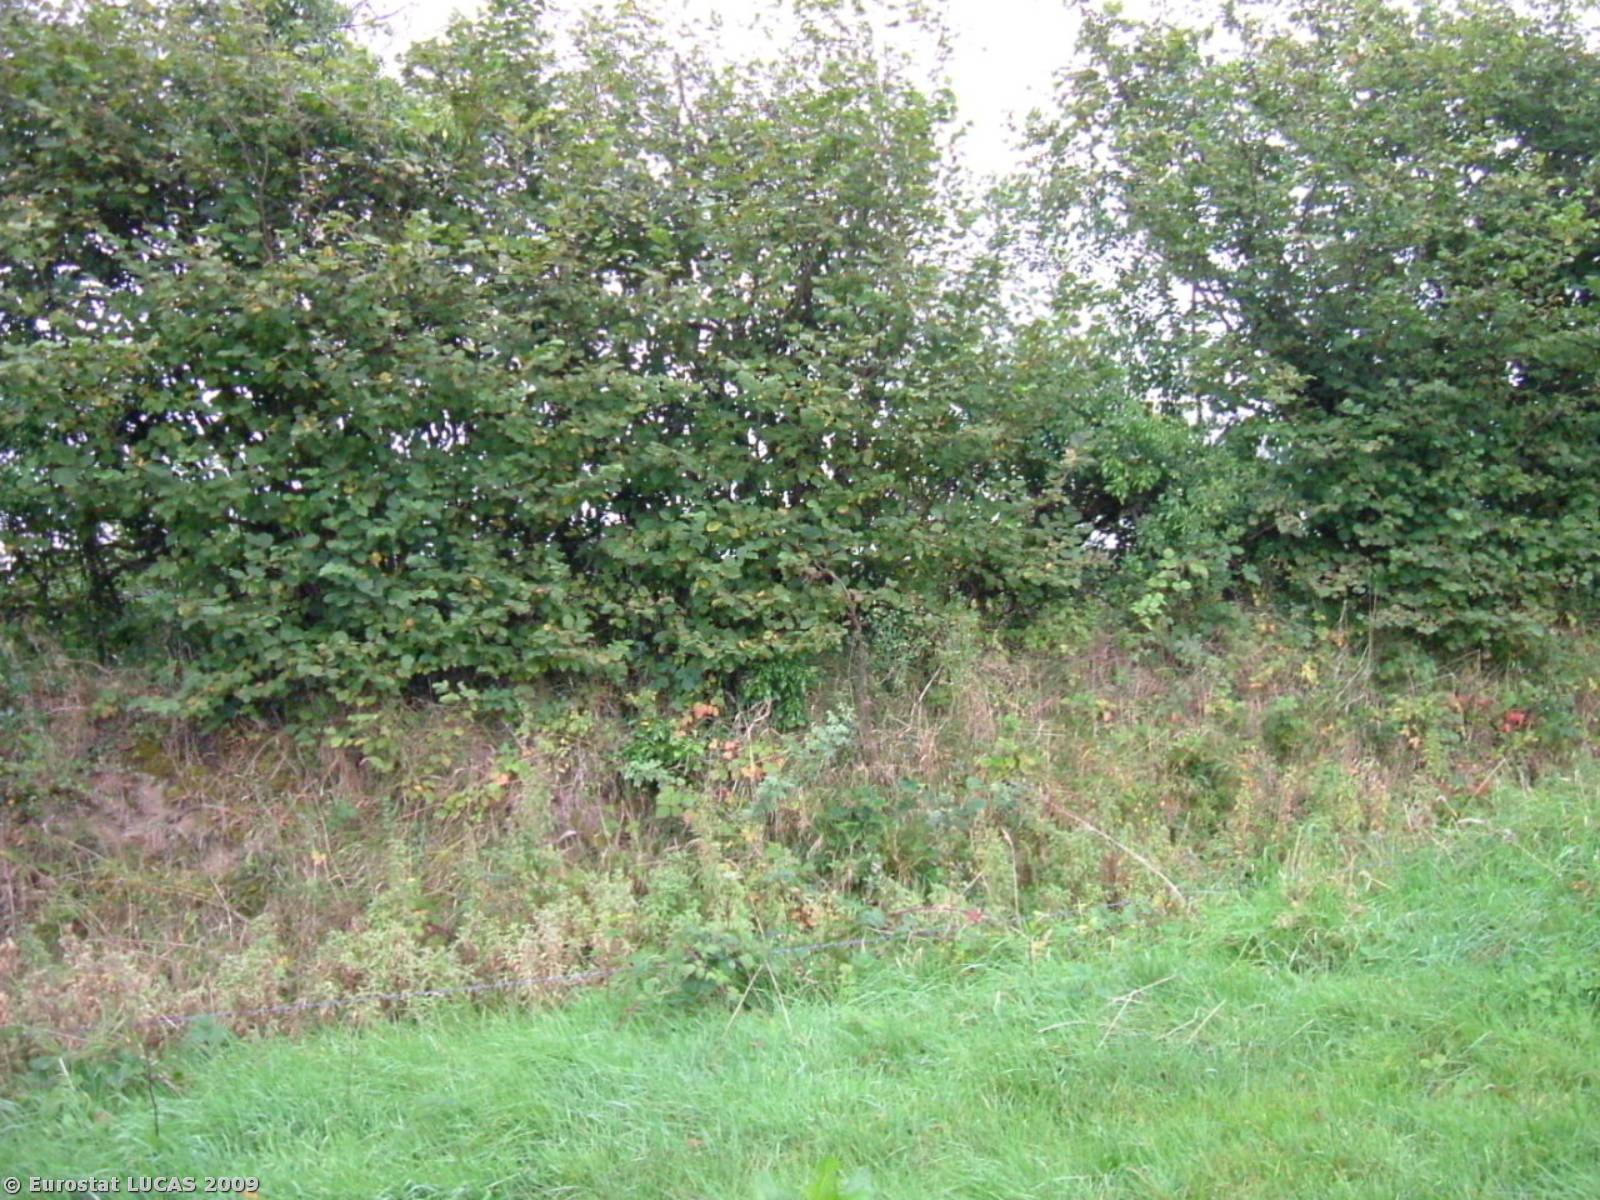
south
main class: Grassland
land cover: Grassland without tree/shrub cover
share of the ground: > 75 %
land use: Agriculture (excluding fallow land and kitchen gardens)
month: September
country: IE
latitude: 52.8906
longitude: -7.8424
